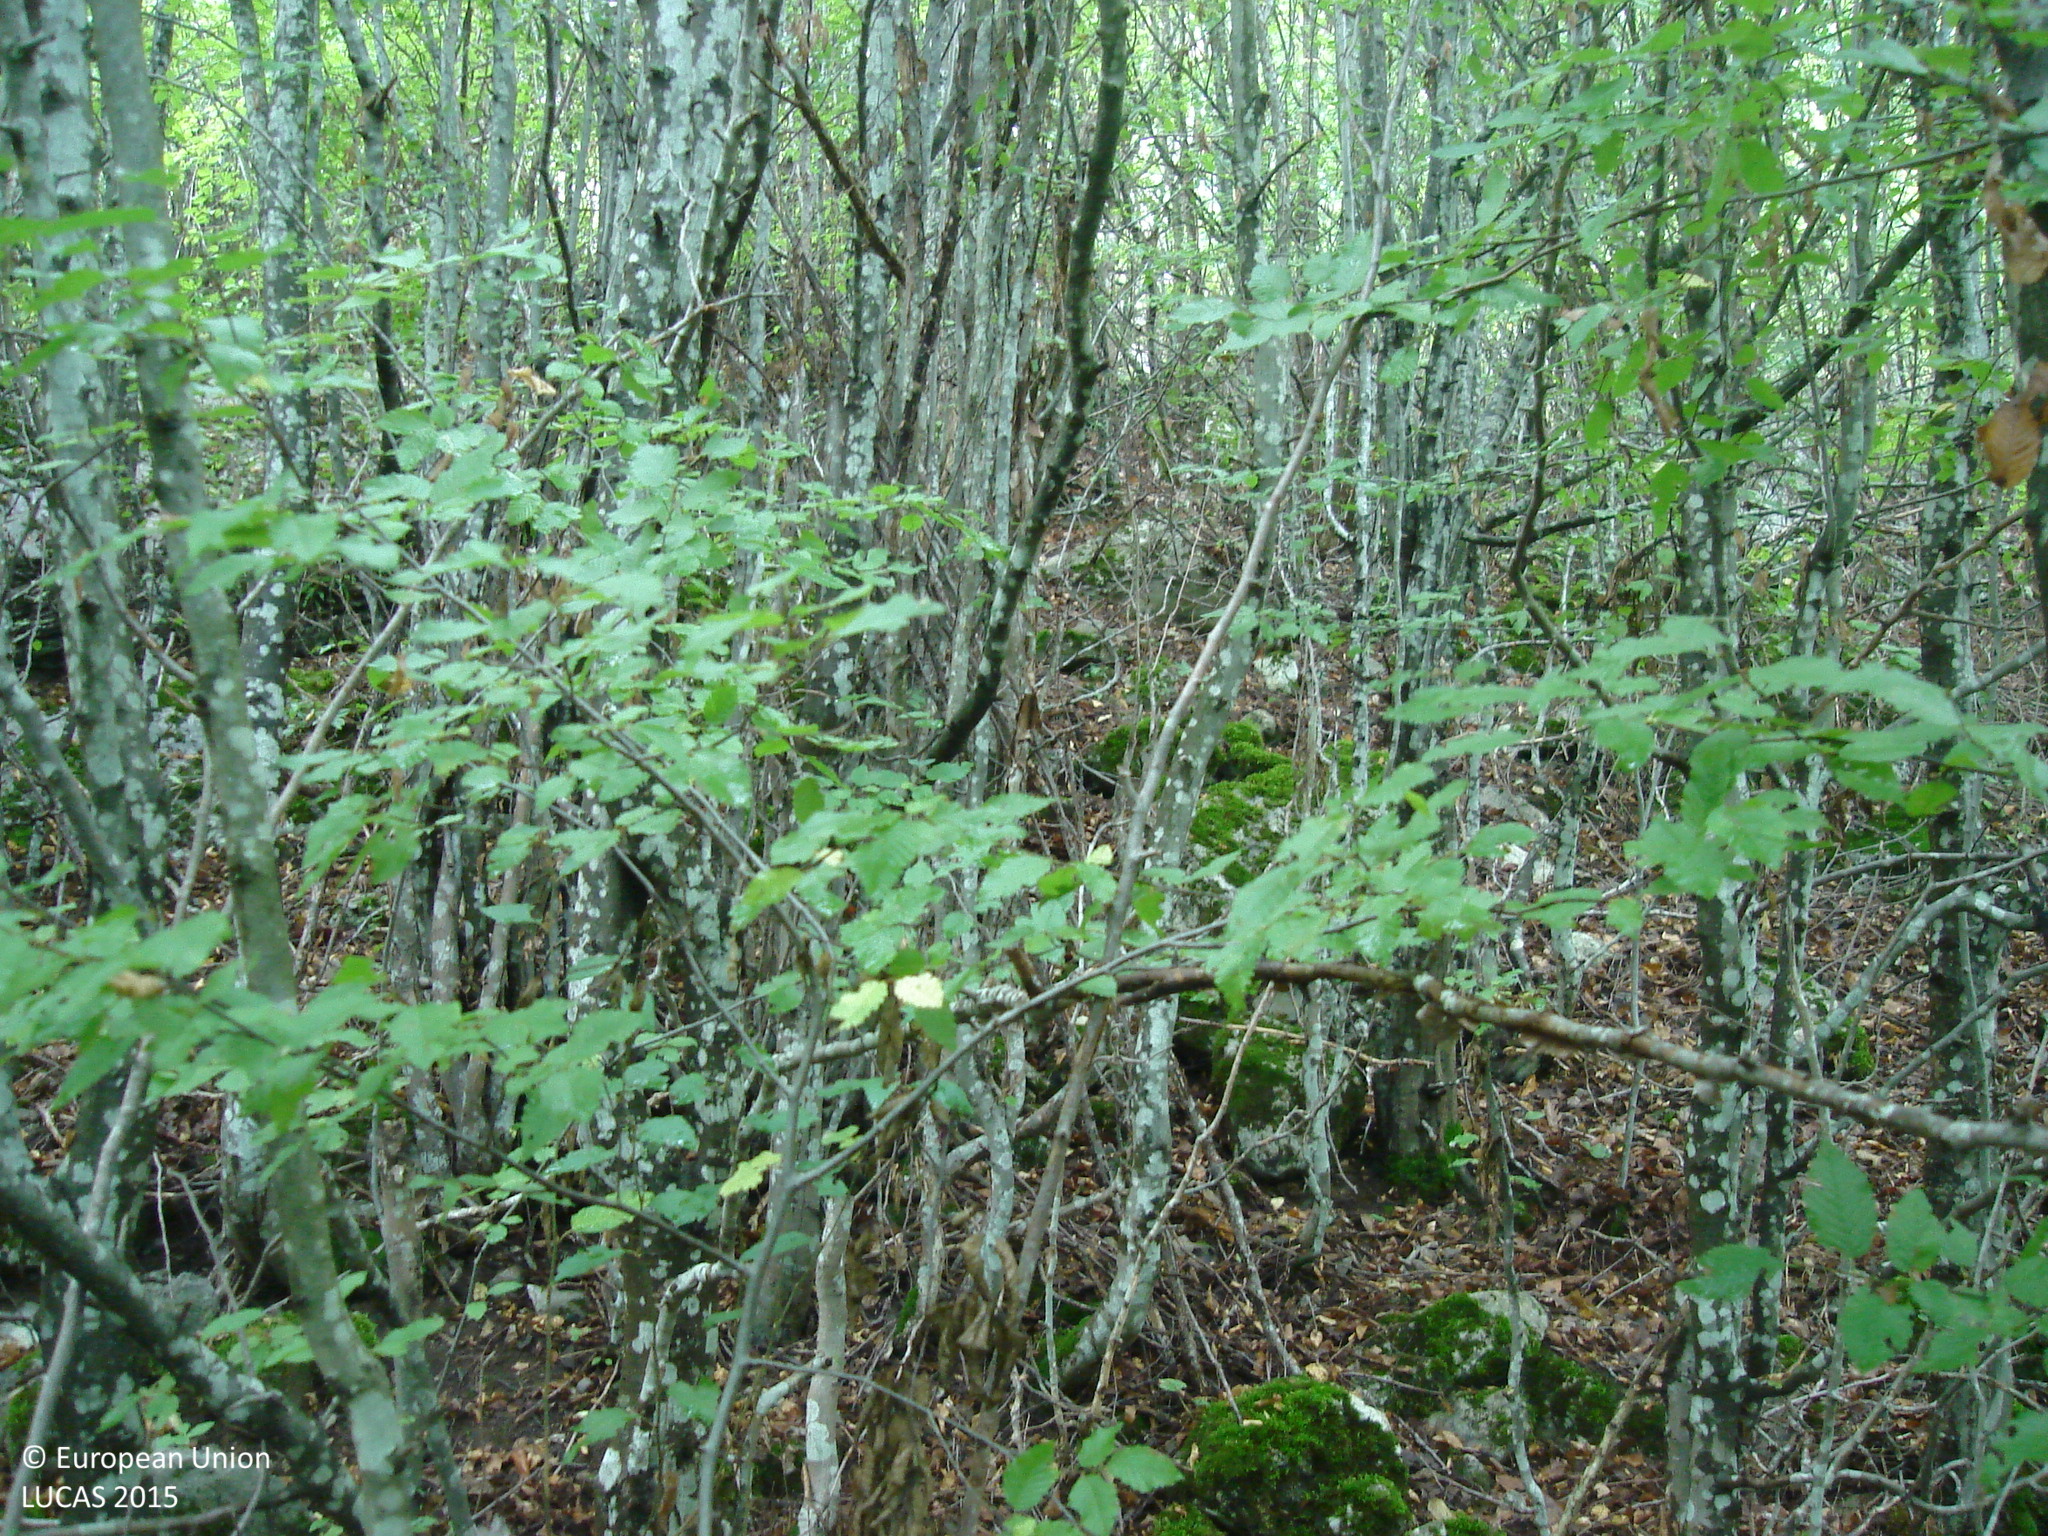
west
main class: Woodland
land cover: Broadleaved woodland
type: mesophytic deciduous forest
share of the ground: > 75 %
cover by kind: broadleaved forest trees 80 %, consolidated bare surface 20 %
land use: Forestry
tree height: > 5 m
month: September
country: BG
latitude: 43.0278
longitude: 23.2039
